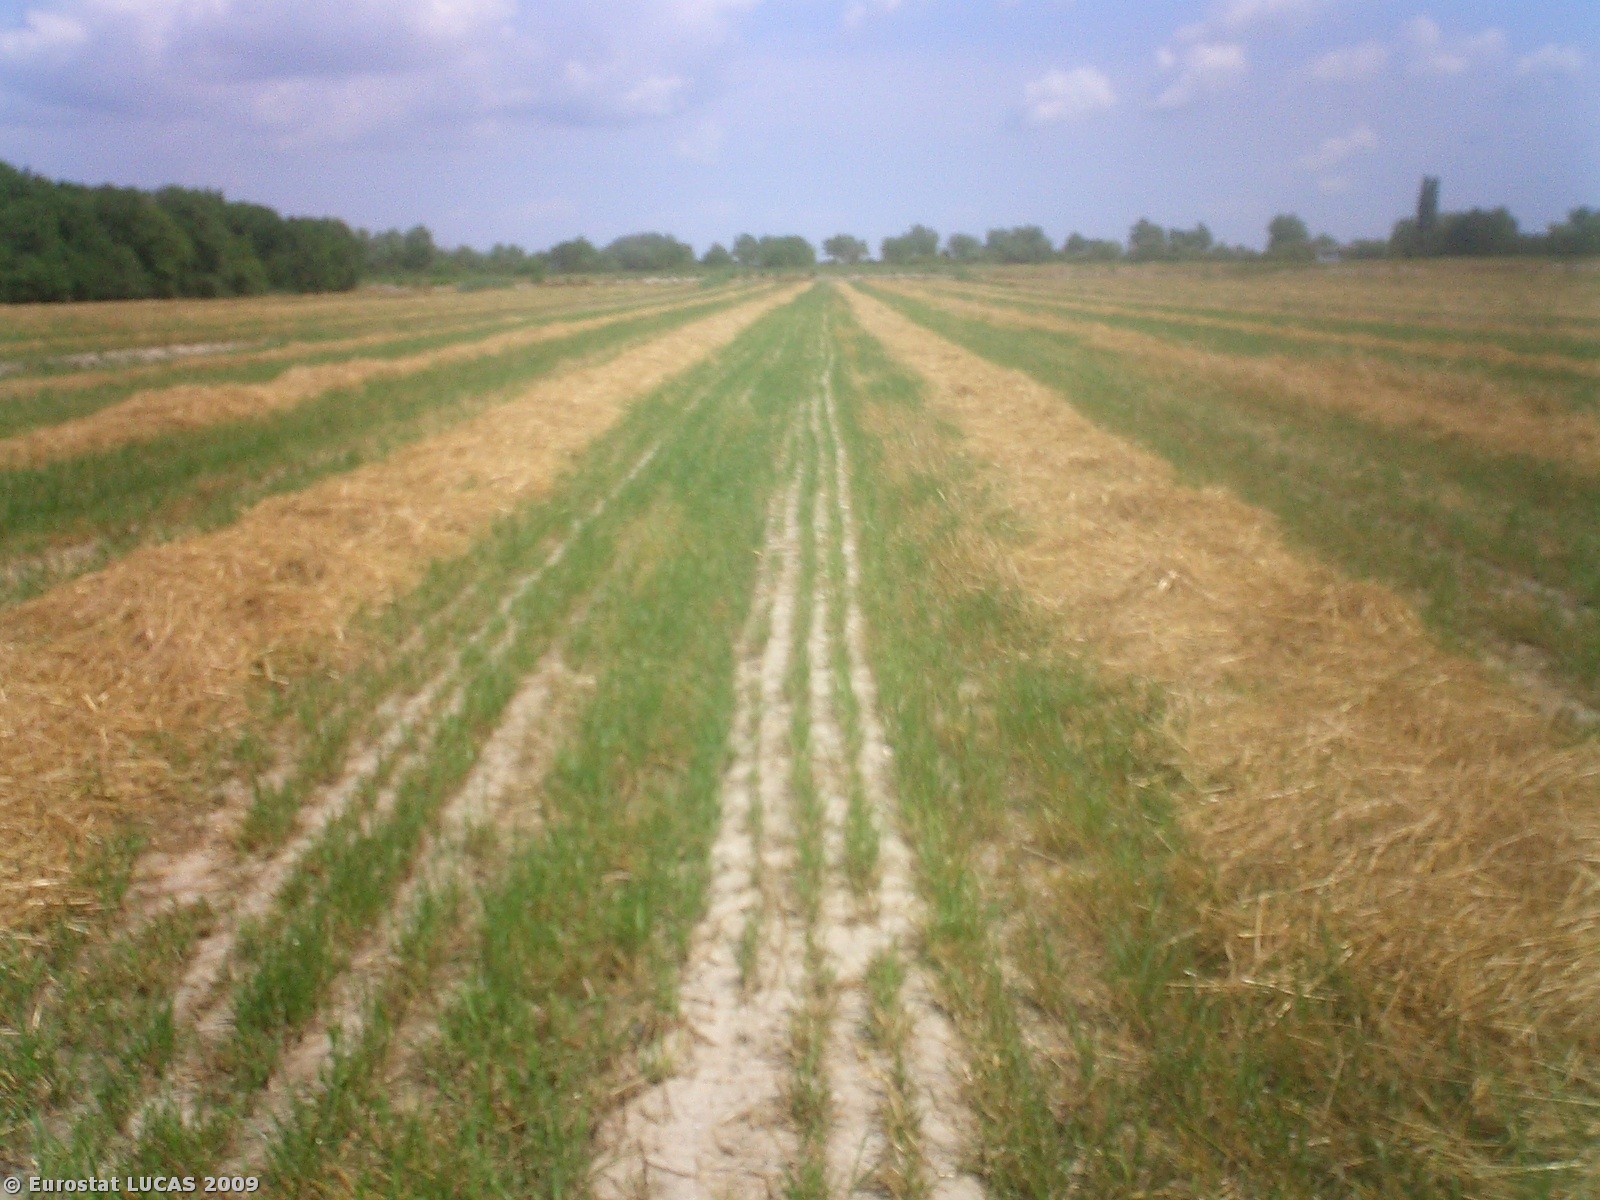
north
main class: Cropland
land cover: Temporary grasslands
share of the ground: > 75 %
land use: Agriculture (excluding fallow land and kitchen gardens)
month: July
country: IT
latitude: 44.7276
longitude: 12.0288
